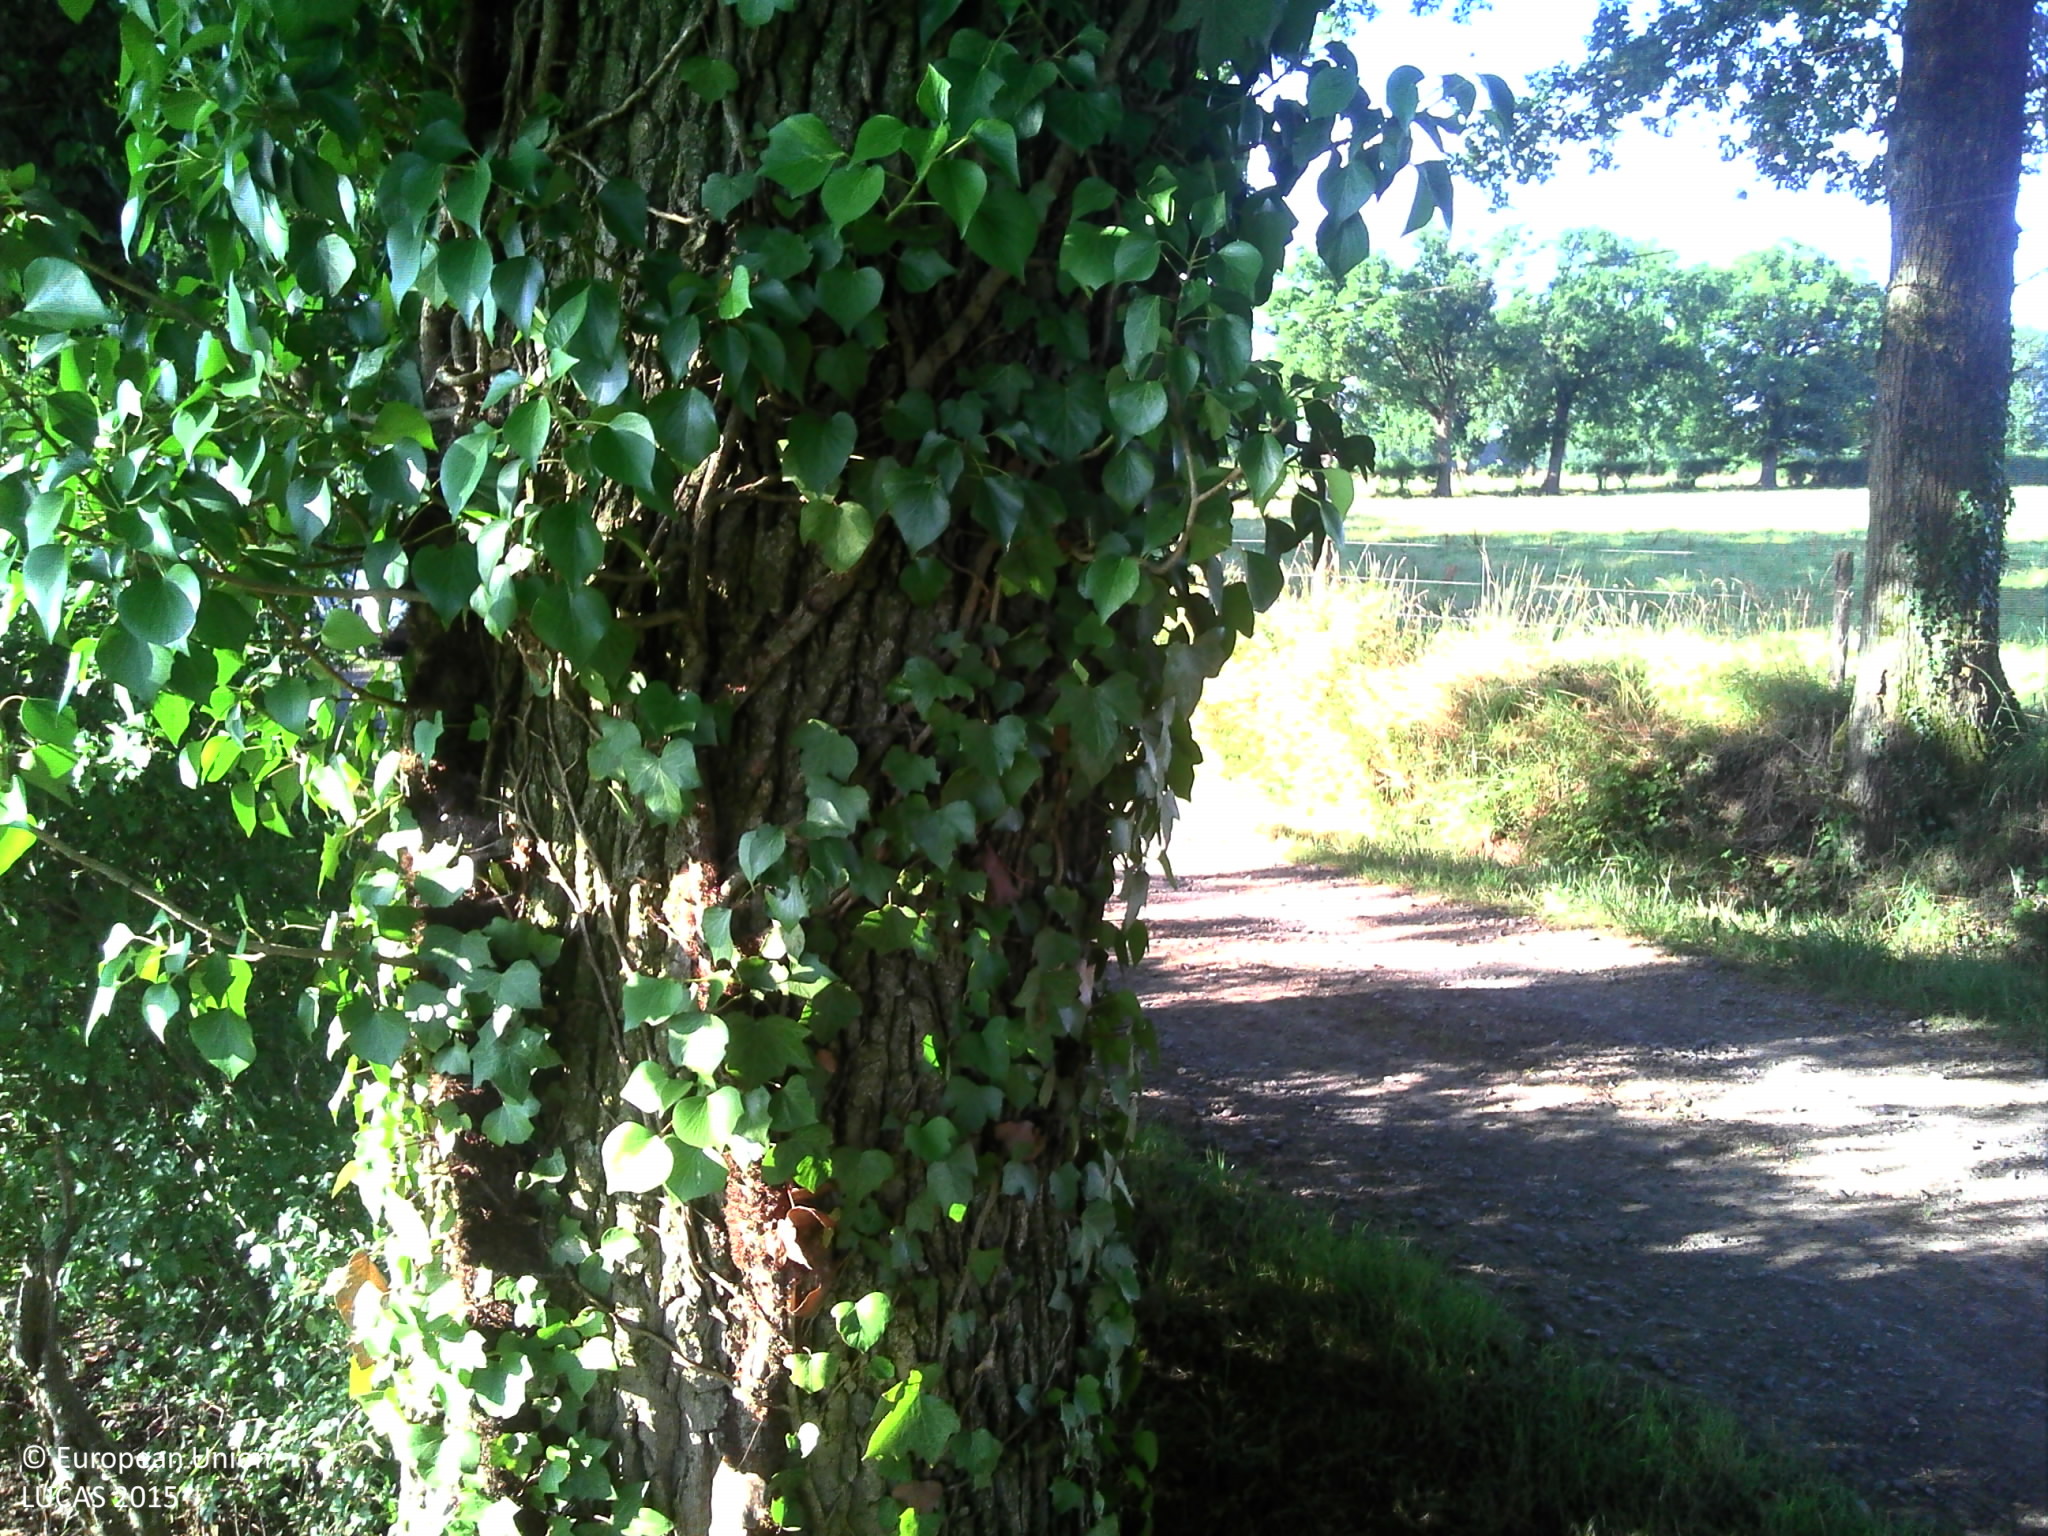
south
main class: Grassland
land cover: Grassland without tree/shrub cover
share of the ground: > 75 %
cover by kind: herbaceous plants 100 %
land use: Agriculture (excluding fallow land and kitchen gardens)
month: June
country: FR
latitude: 46.3501
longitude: 0.9816
